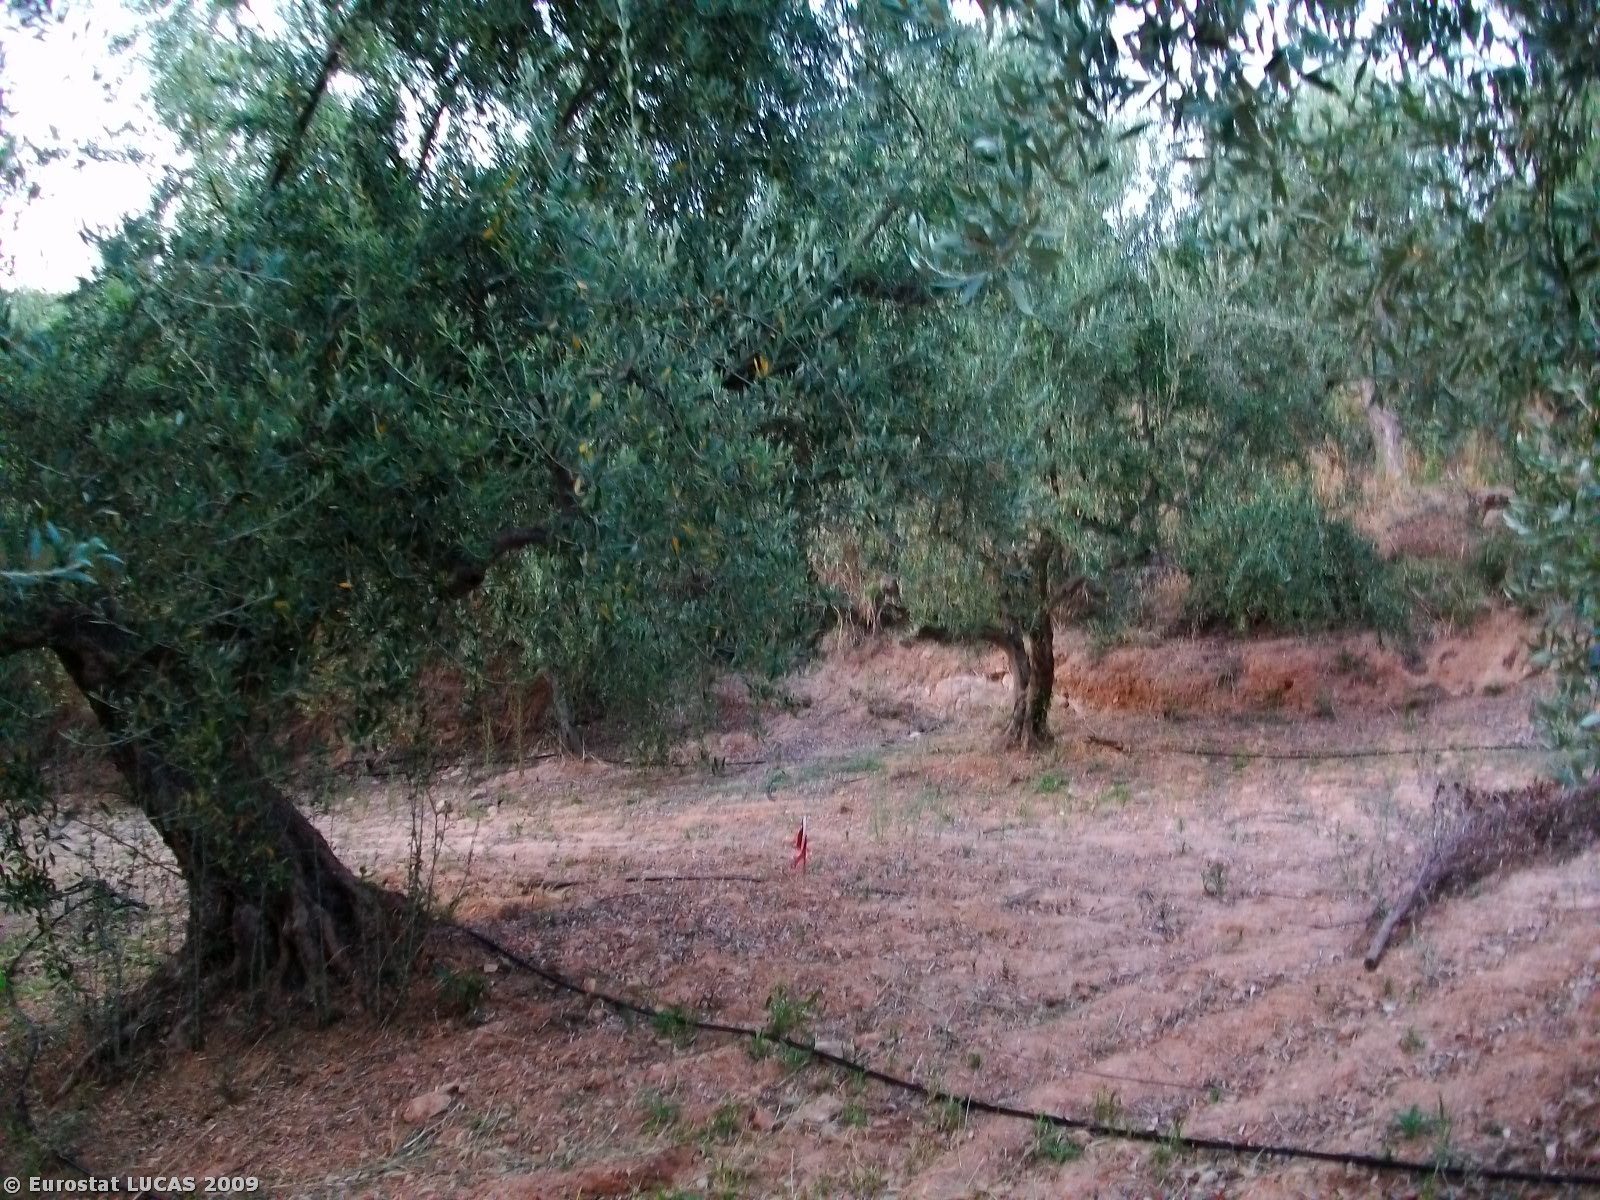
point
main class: Cropland
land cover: Olive groves
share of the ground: 25 - 50 %
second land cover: Bare land
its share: > 75 %
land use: Agriculture (excluding fallow land and kitchen gardens)
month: August
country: GR
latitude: 36.8696
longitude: 22.7321
